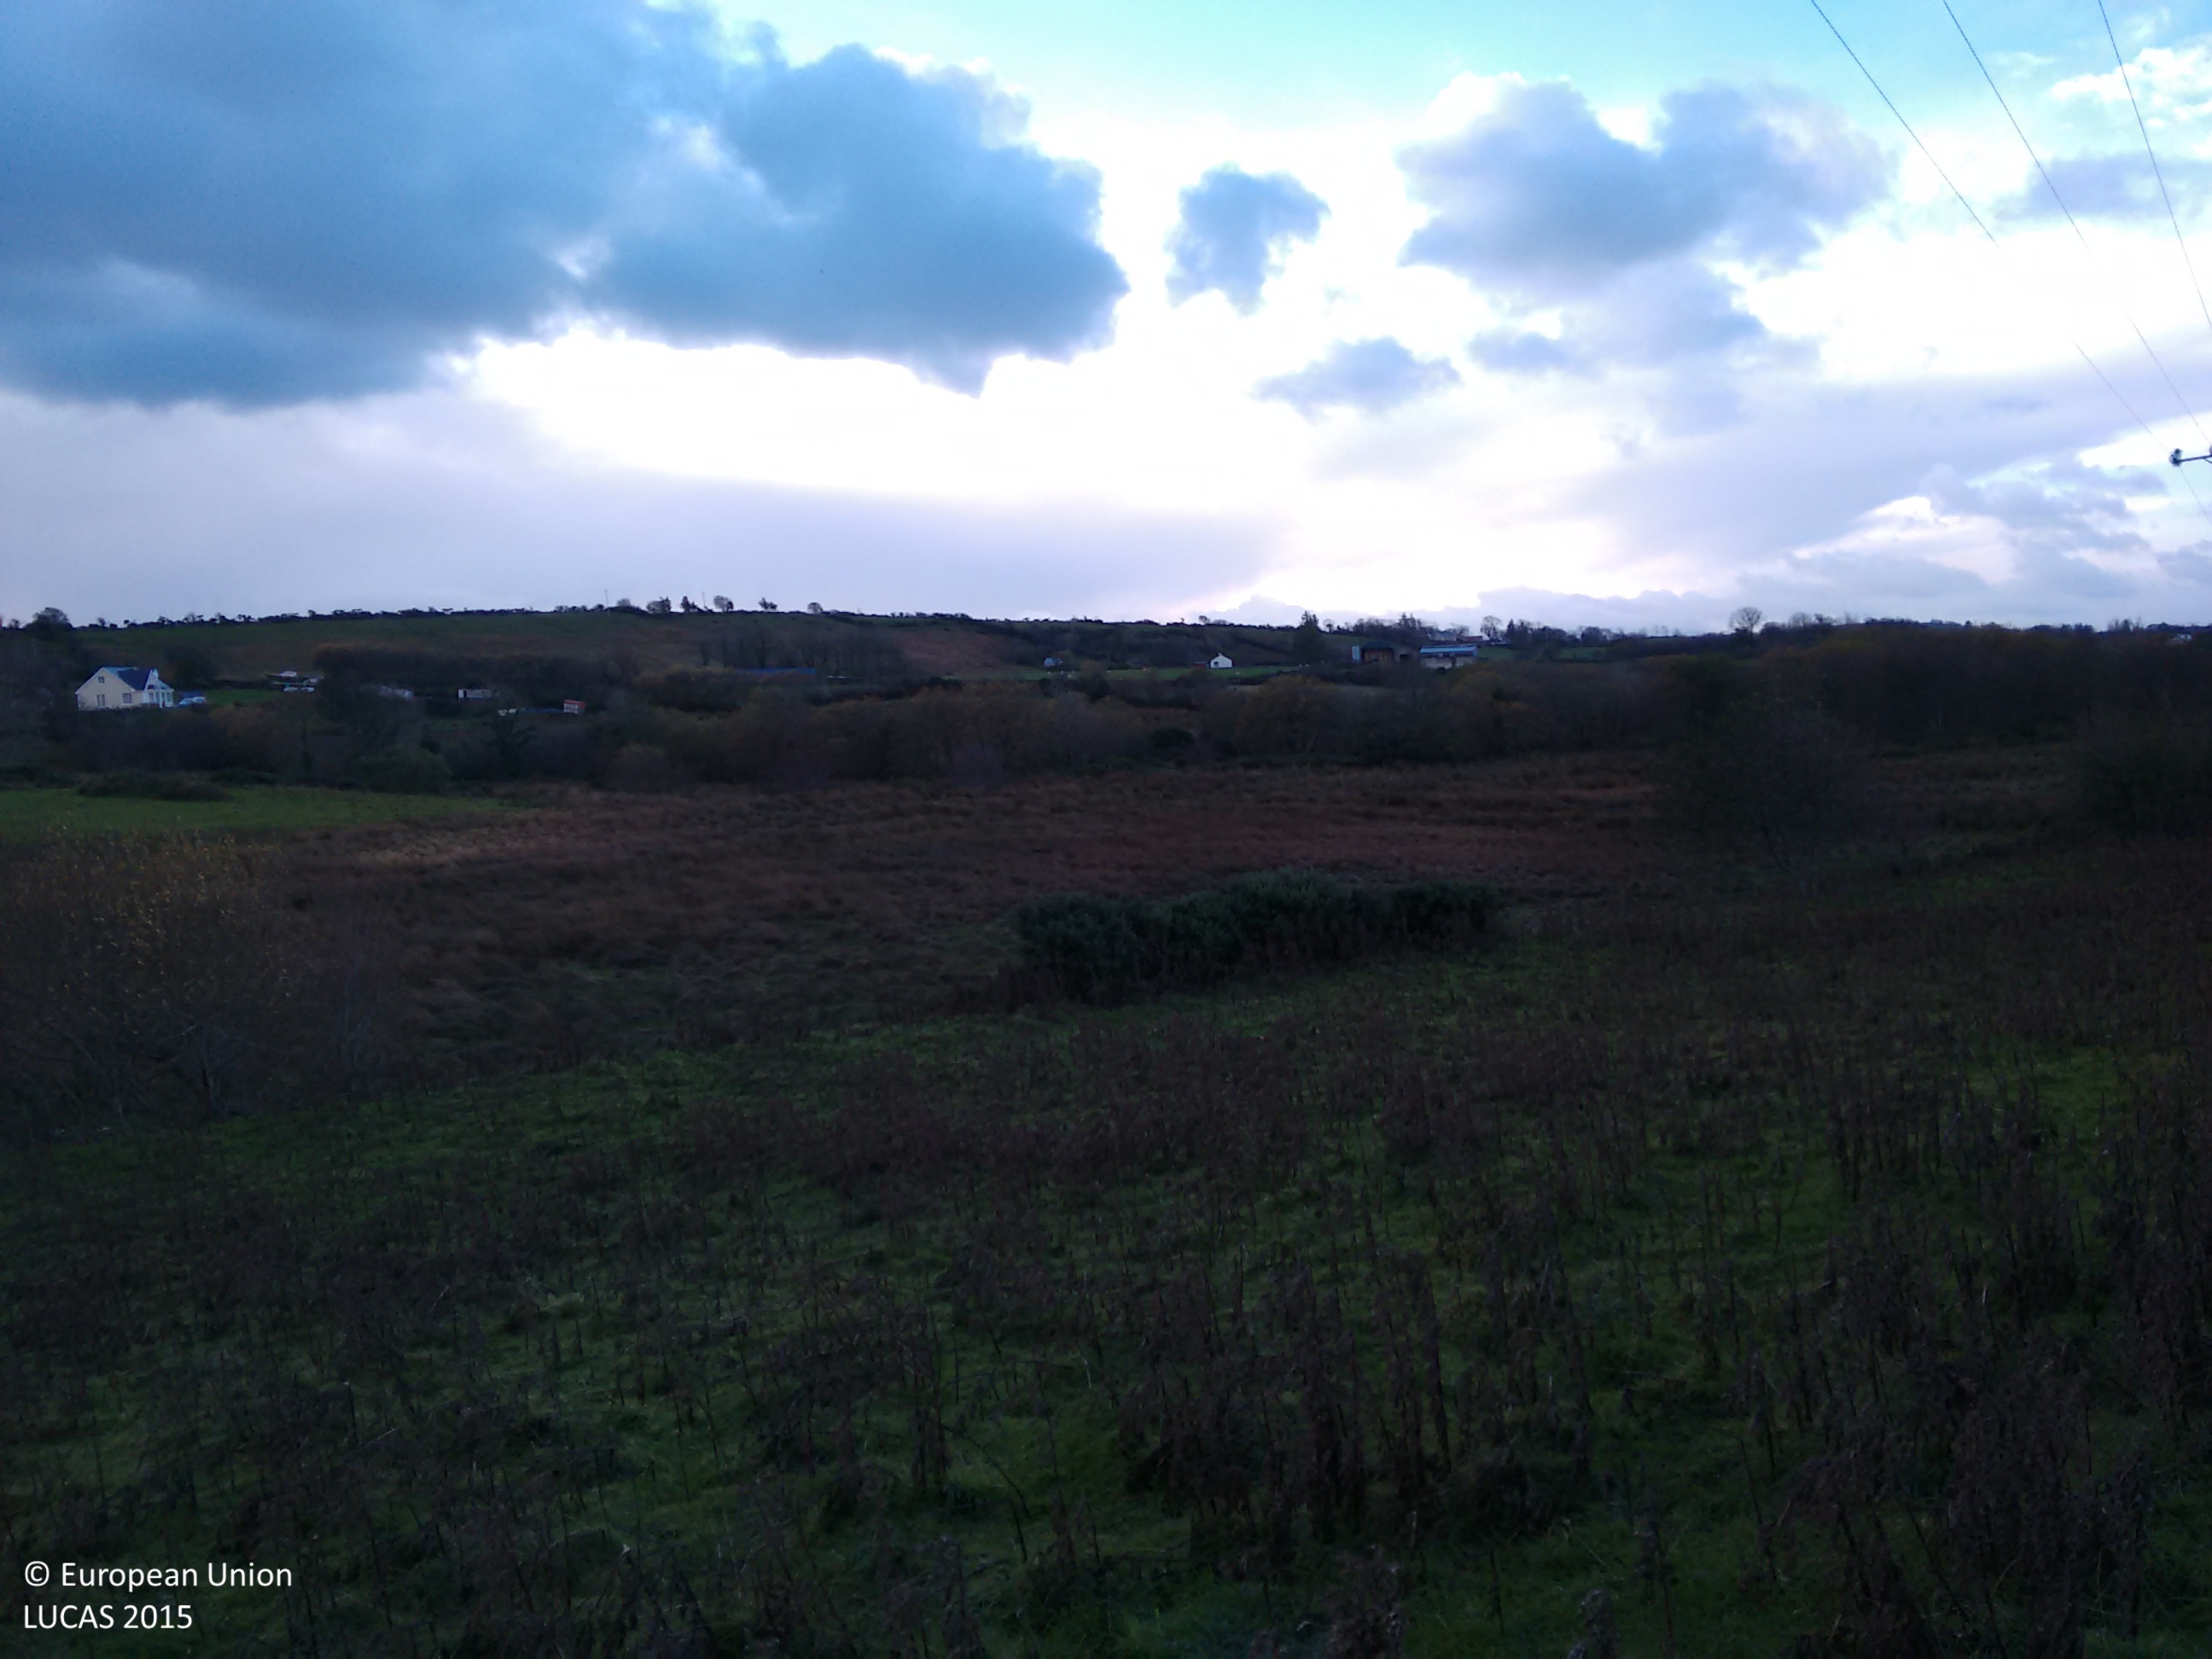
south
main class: Grassland
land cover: Grassland without tree/shrub cover
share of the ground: > 75 %
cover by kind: herbaceous plants 100 %
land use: Agriculture (excluding fallow land and kitchen gardens)
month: November
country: IE
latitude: 54.6373
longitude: -8.2628
